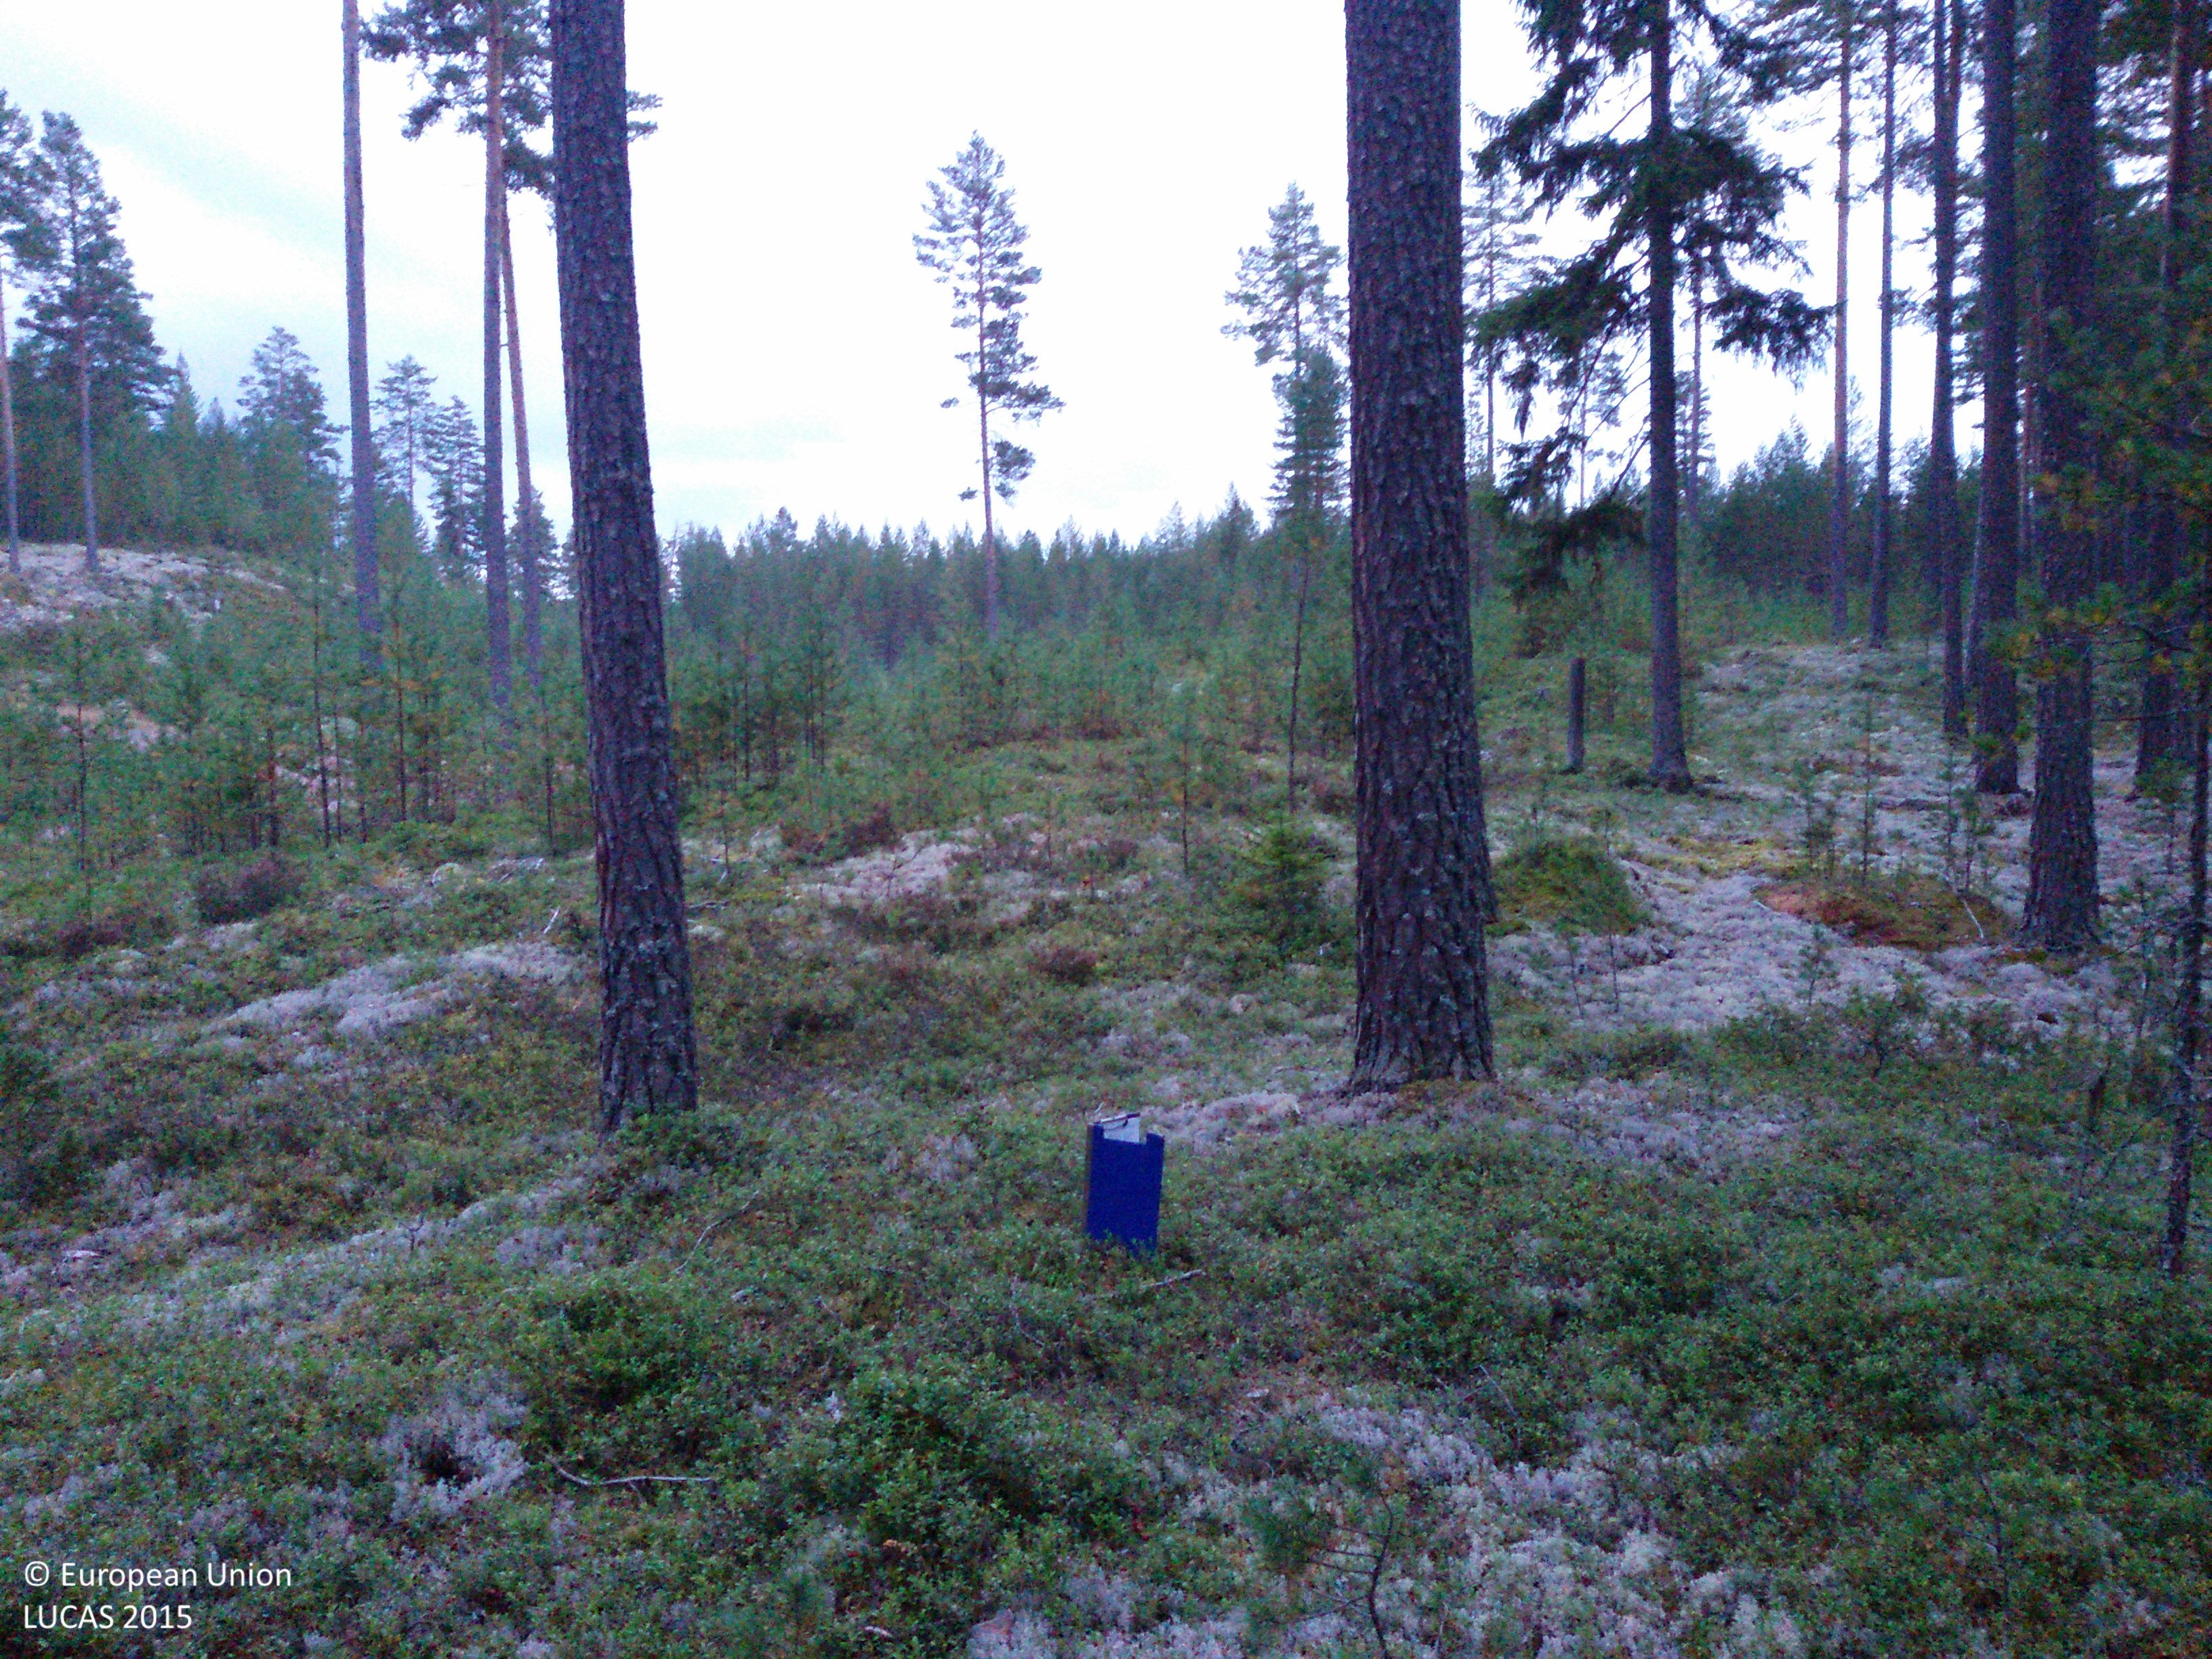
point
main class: Woodland
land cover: Pine dominated coniferous woodland
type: boreal forest
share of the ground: 50 - 75 %
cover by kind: coniferous forest trees 65 %, lichens and mosses 25 %, shrubs 10 %
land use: Forestry
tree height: > 5 m
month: August
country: SE
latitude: 60.9895
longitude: 16.0675
